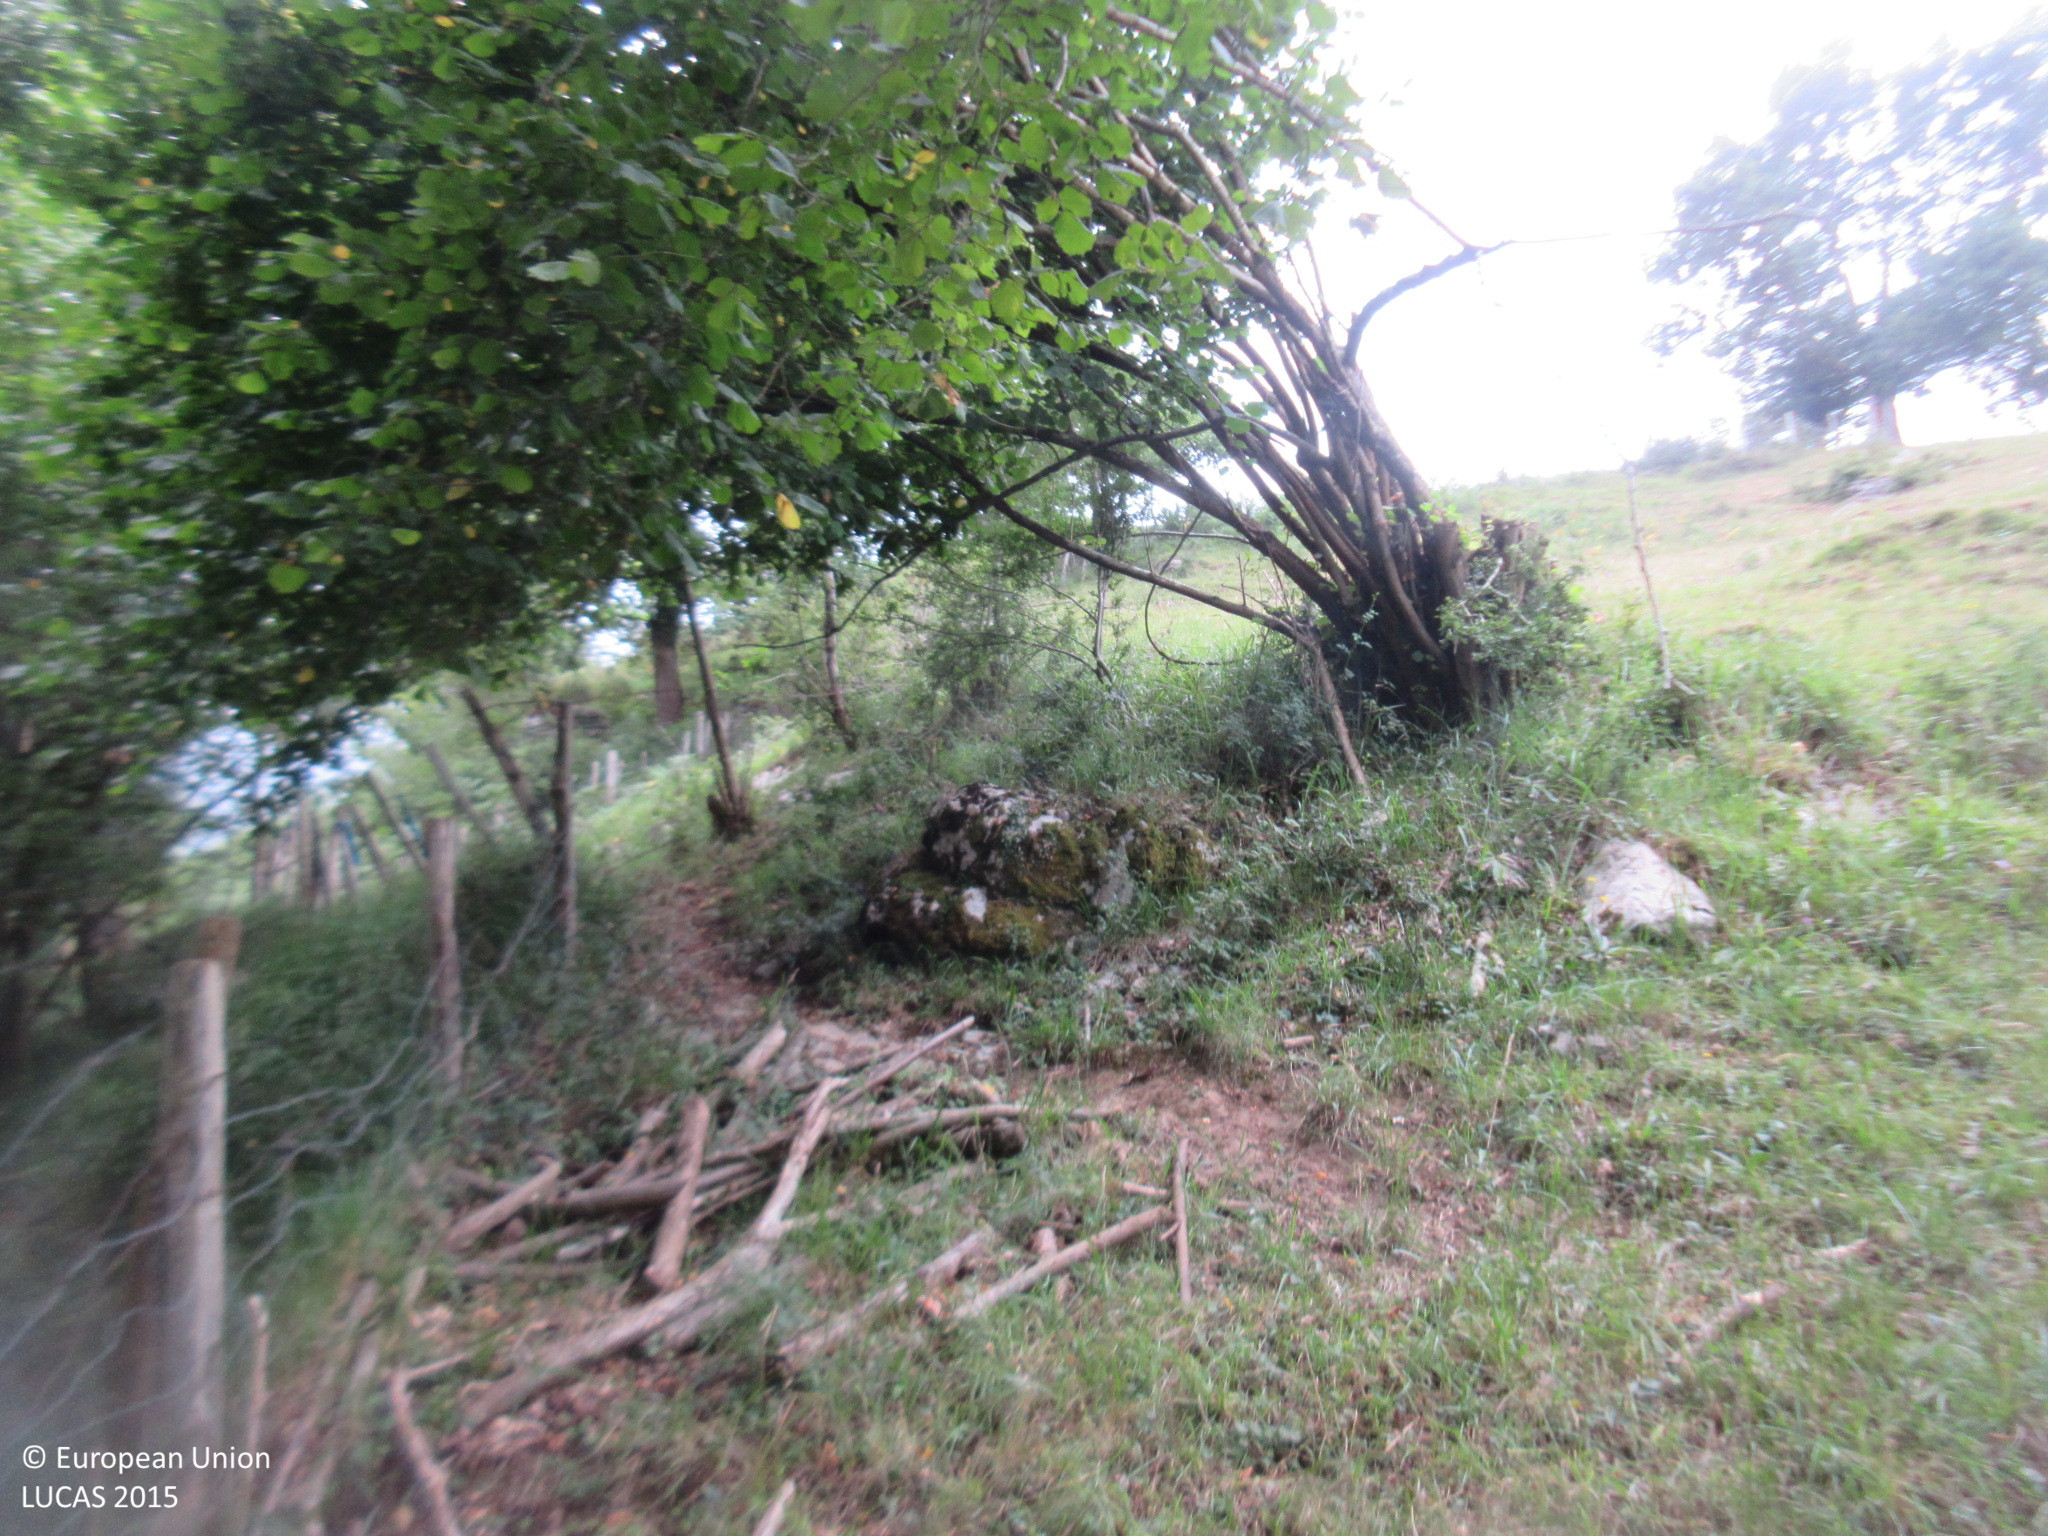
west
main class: Woodland
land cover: Pine dominated coniferous woodland
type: hemiboreal forest and nemoral coniferous forest and mixed broadleaved-coniferous forest
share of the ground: > 75 %
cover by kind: coniferous forest trees 90 %, shrubs 10 %
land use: Forestry
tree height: > 5 m
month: July
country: ES
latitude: 43.2145
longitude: -4.1220
